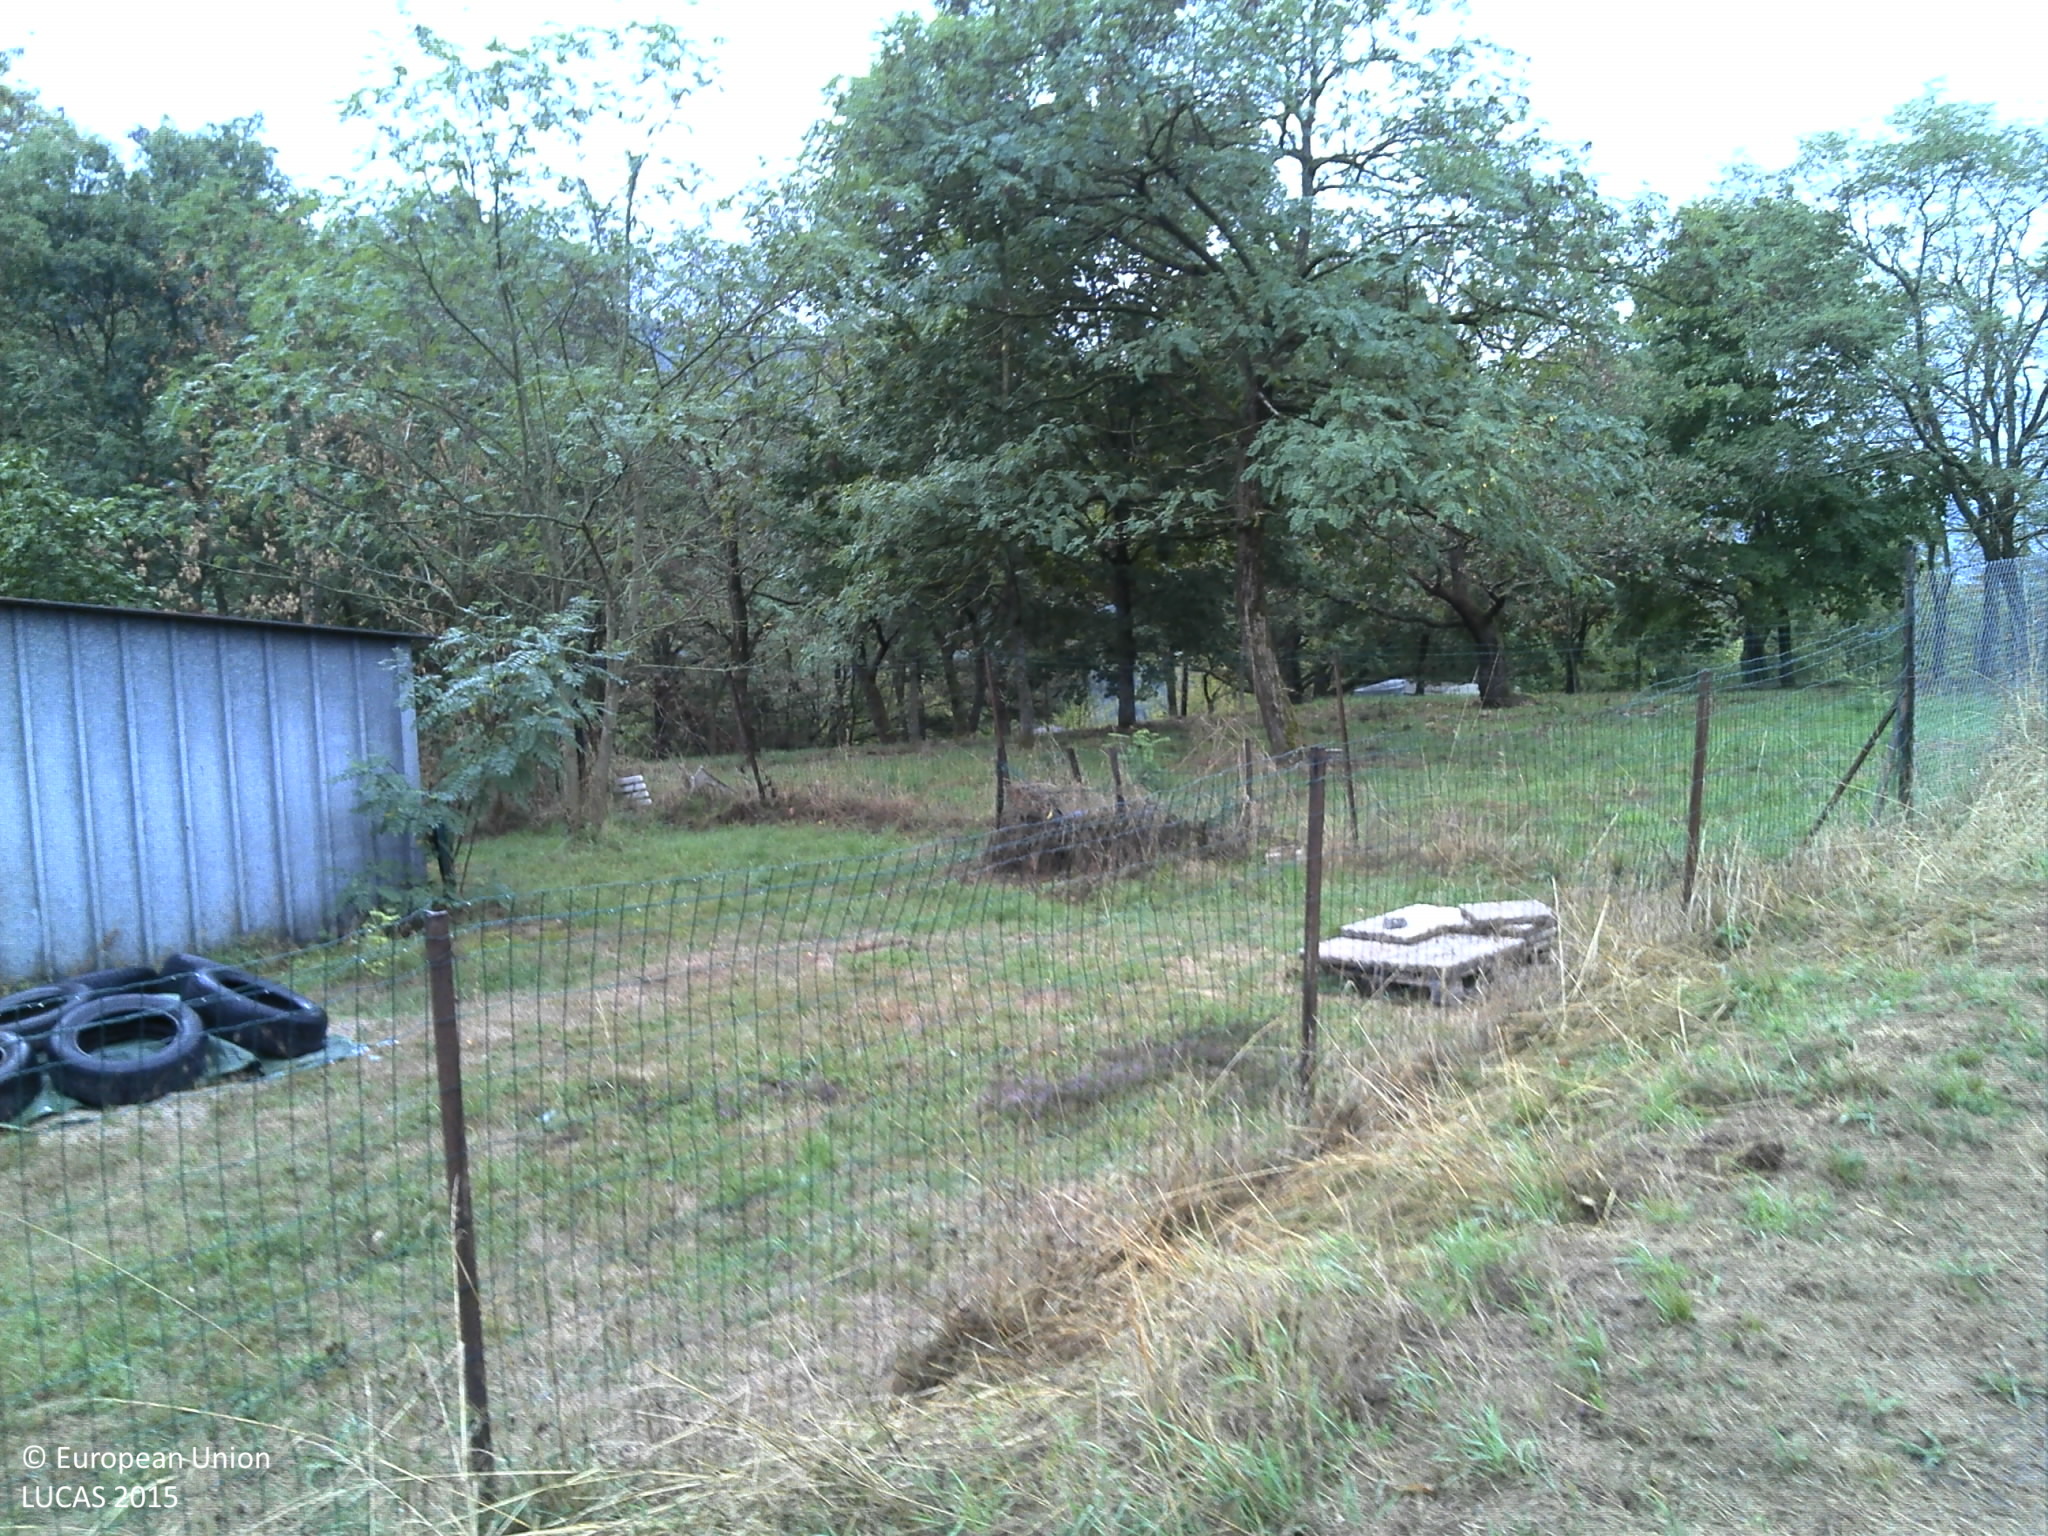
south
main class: Grassland
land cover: Grassland without tree/shrub cover
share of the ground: > 75 %
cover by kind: herbaceous plants 100 %
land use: Agriculture (excluding fallow land and kitchen gardens)
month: September
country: FR
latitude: 48.5141
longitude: 7.2798
